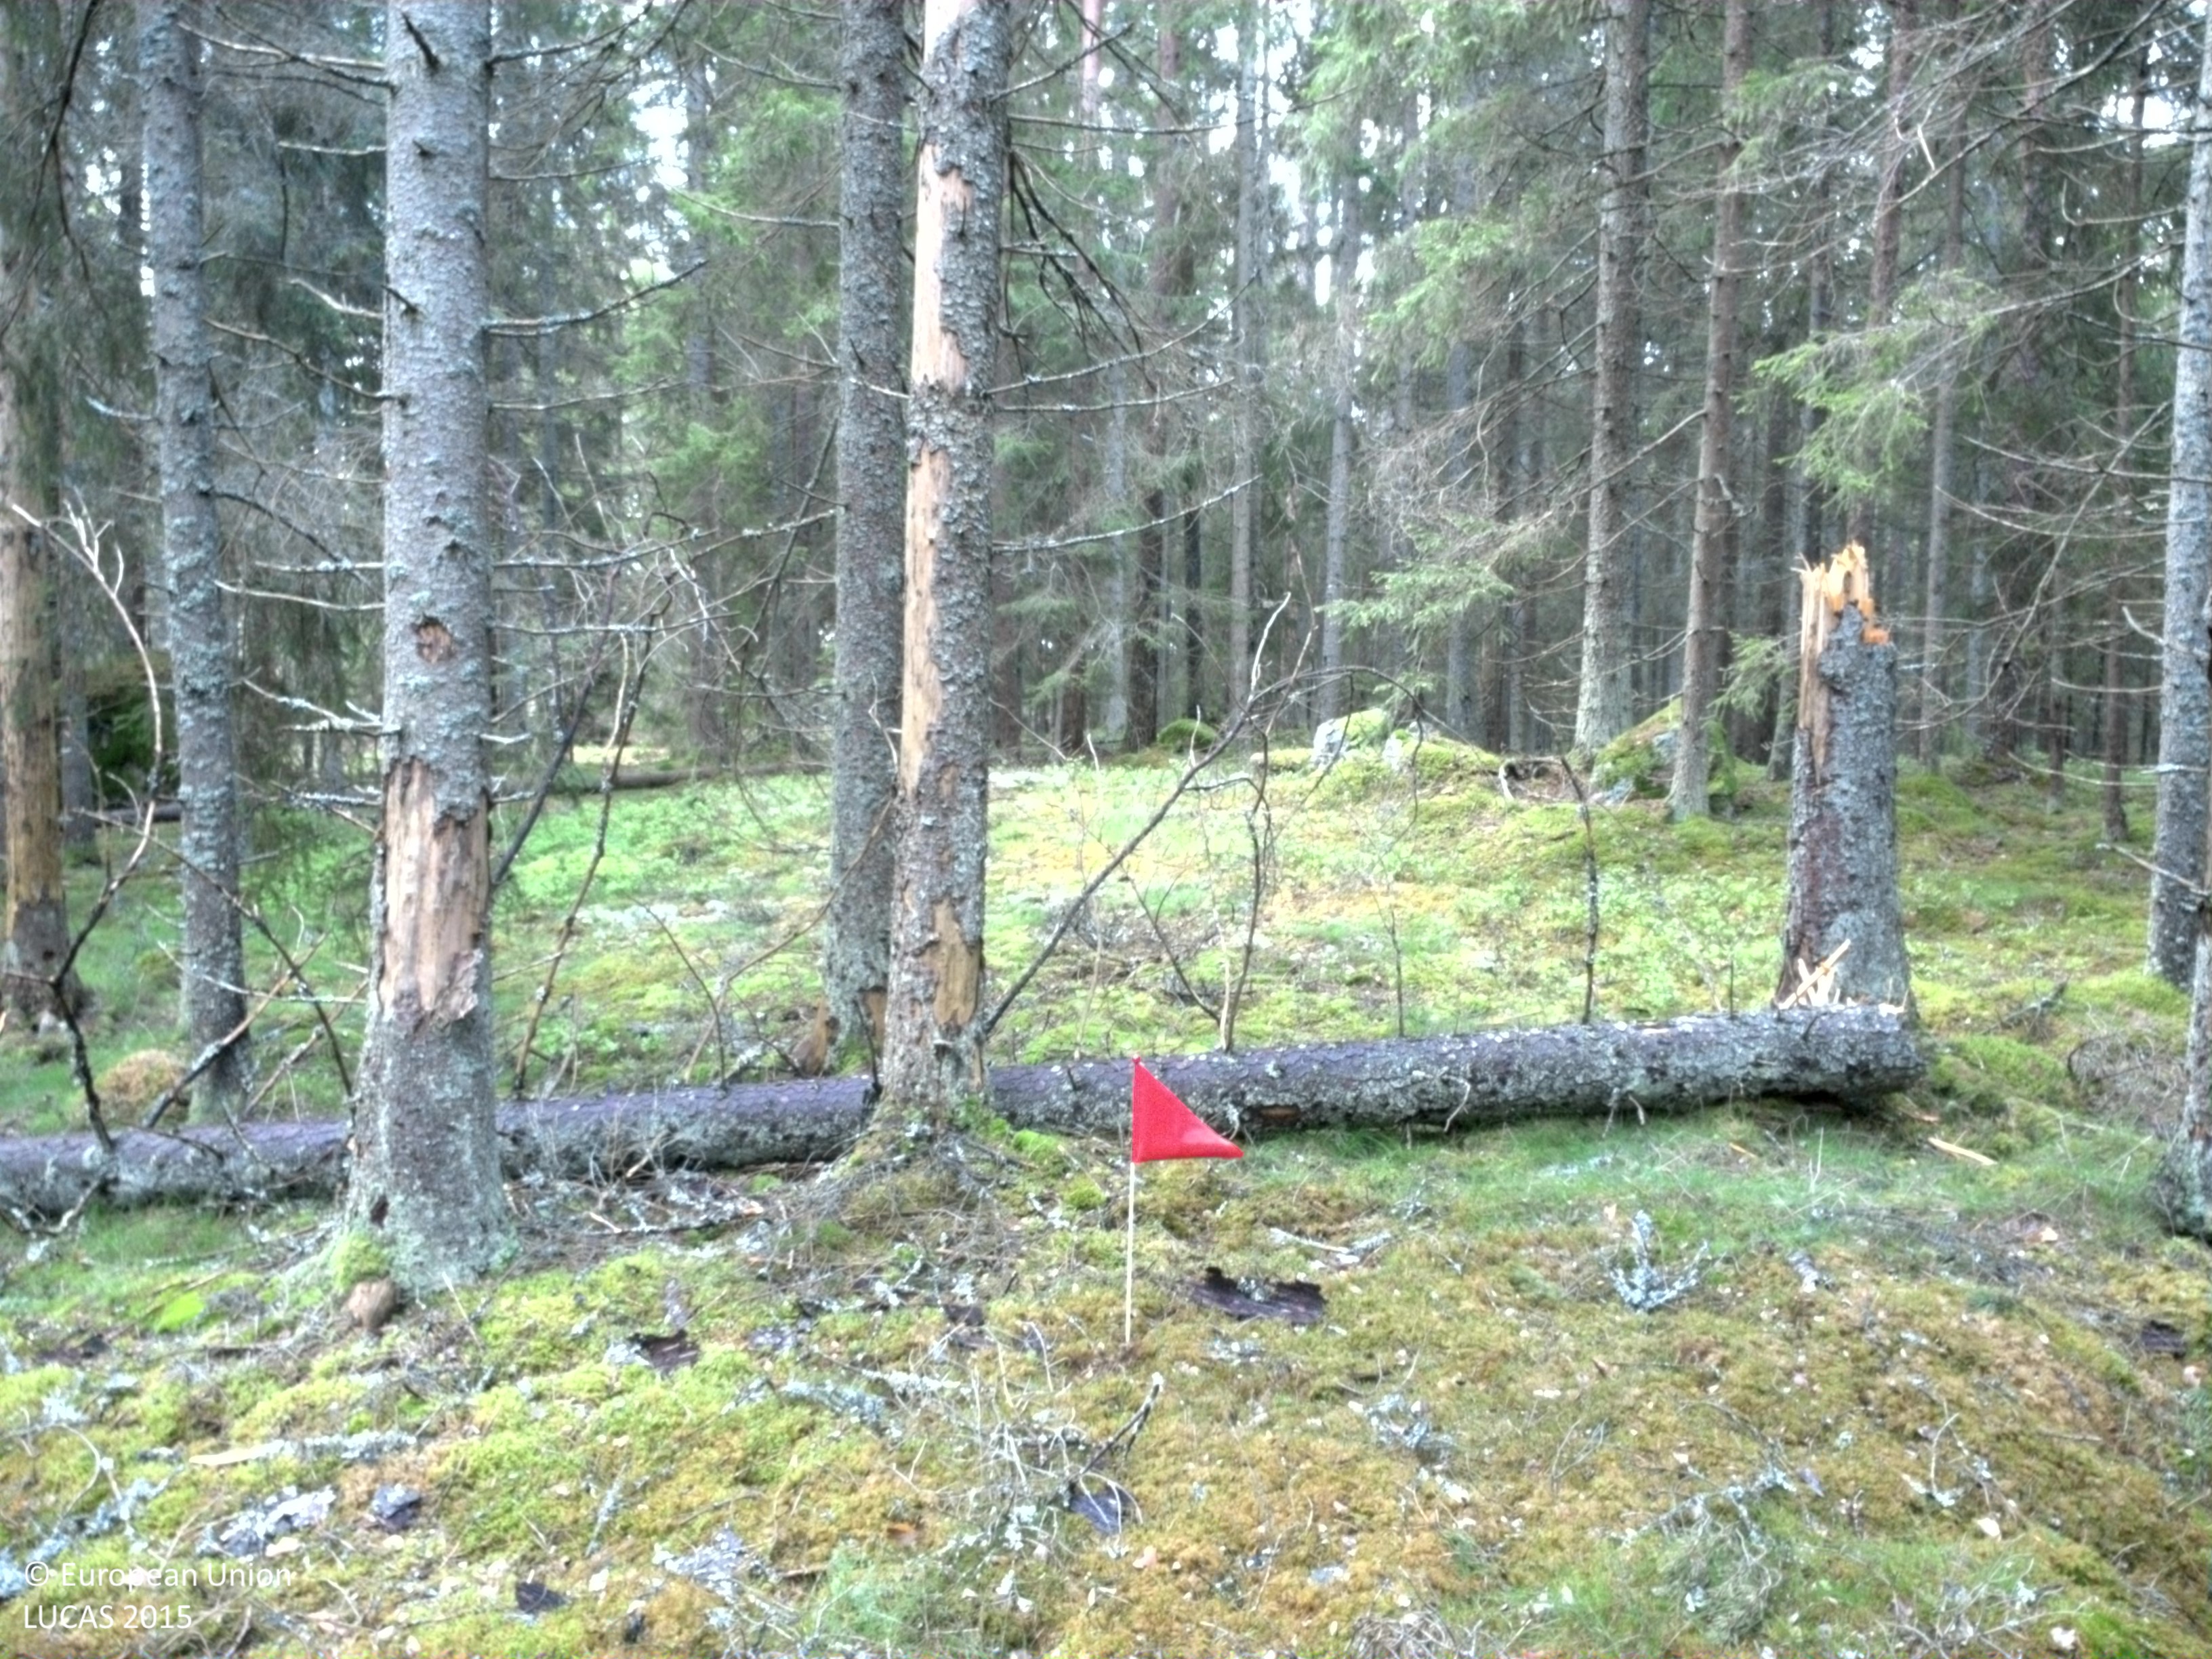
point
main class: Woodland
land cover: Spruce dominated coniferous woodland
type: boreal forest
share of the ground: 50 - 75 %
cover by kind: coniferous forest trees 55 %, lichens and mosses 35 %, shrubs 5 %, herbaceous plants 5 %
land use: Forestry
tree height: > 5 m
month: May
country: SE
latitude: 56.8434
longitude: 15.0961
